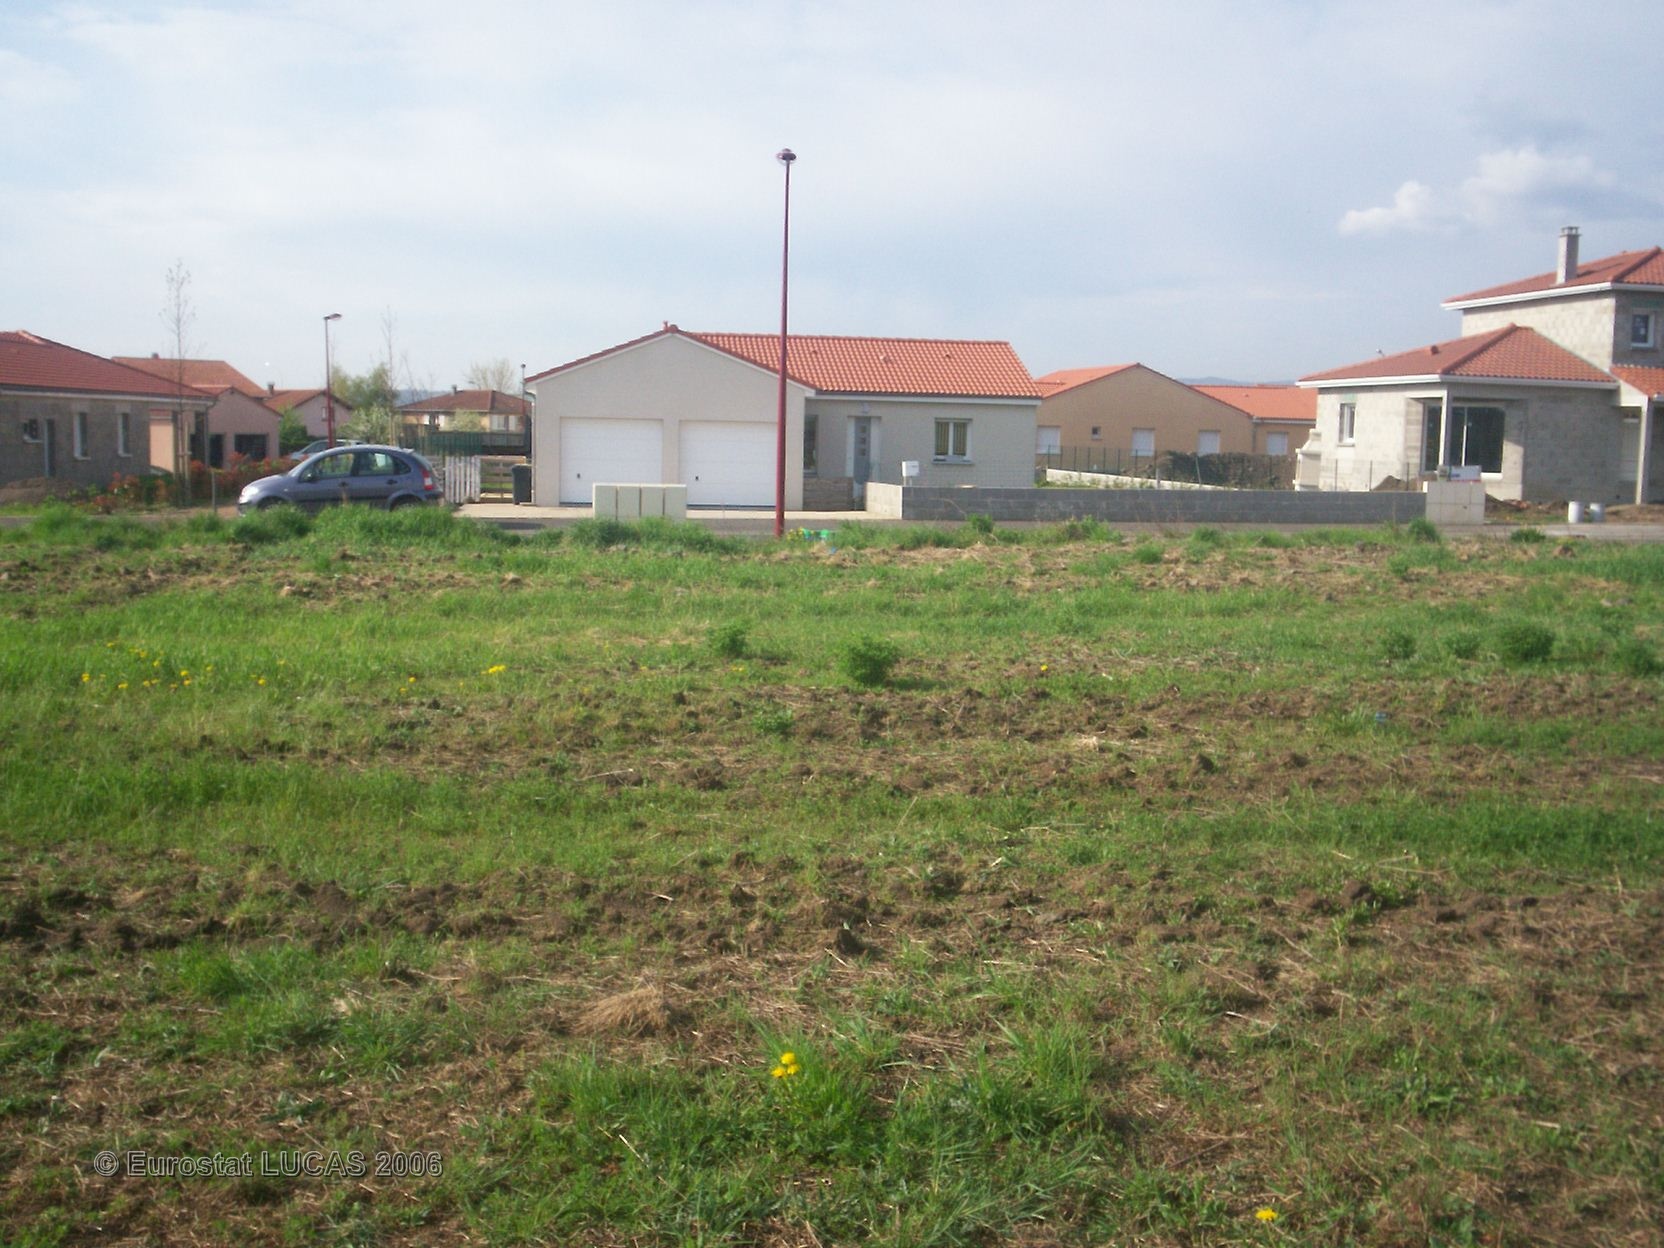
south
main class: Grassland
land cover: Grassland without tree/shrub cover
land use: Fallow land
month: April
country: FR
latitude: 45.8561
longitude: 3.0834
